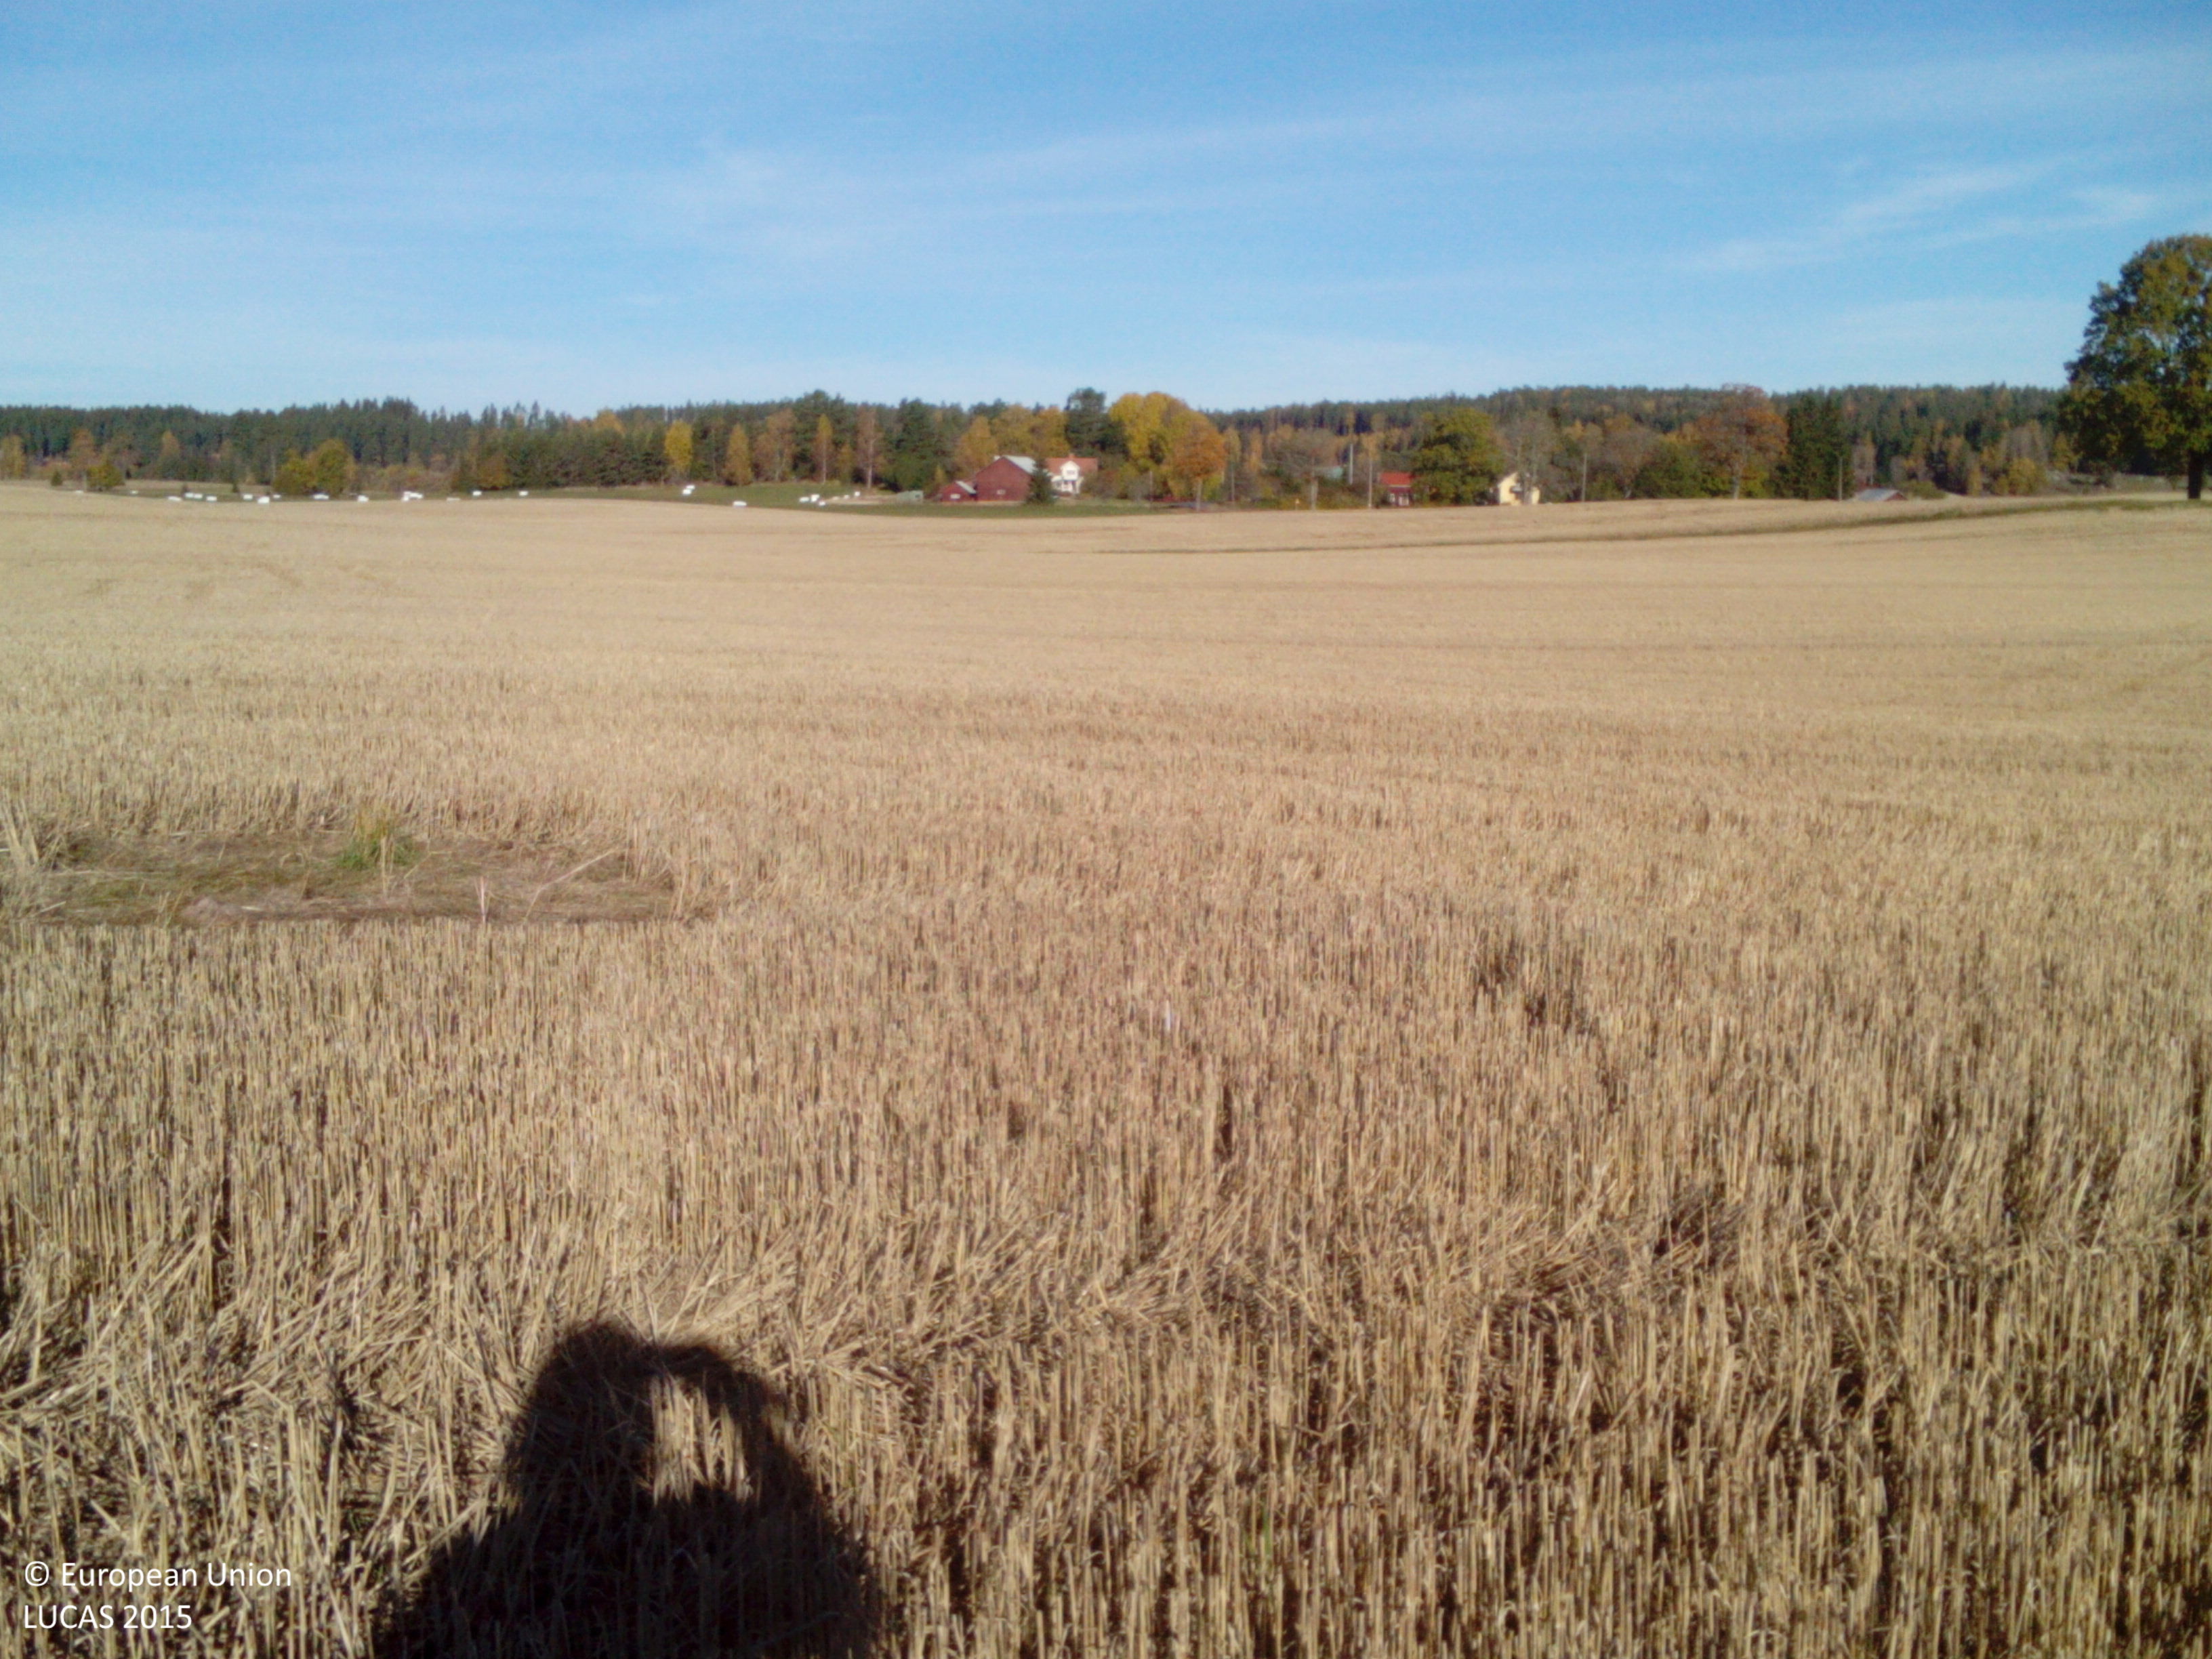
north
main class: Cropland
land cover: Common wheat
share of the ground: > 75 %
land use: Agriculture (excluding fallow land and kitchen gardens)
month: October
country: SE
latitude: 59.0408
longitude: 16.4250
